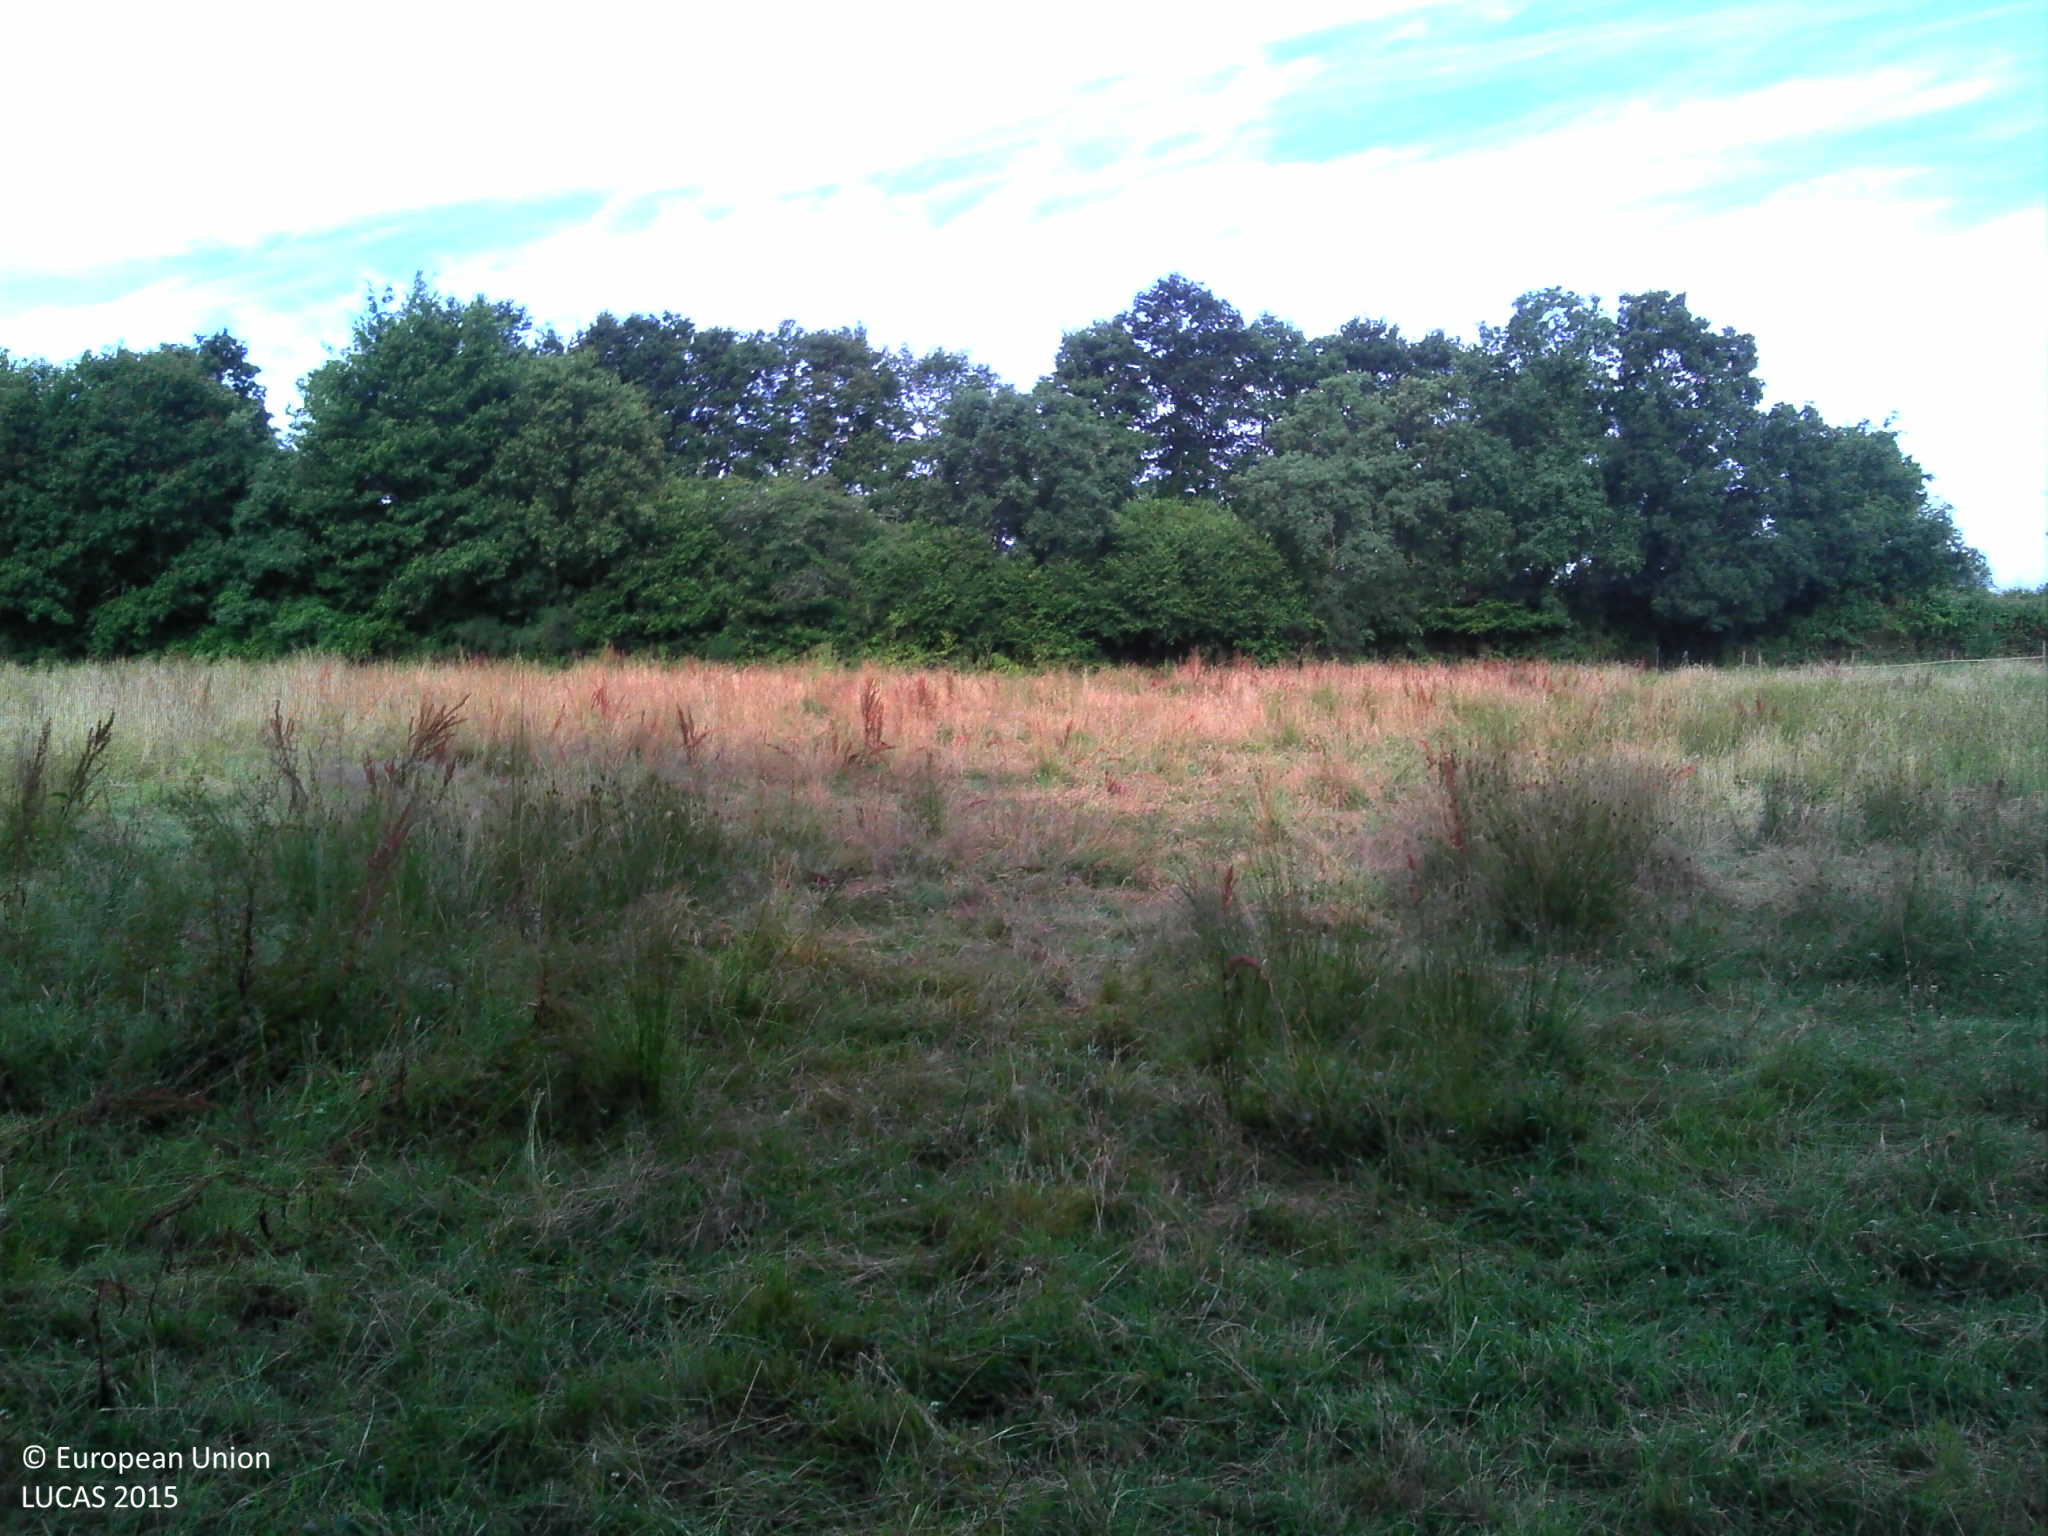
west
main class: Woodland
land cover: Broadleaved woodland
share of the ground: > 75 %
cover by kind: broadleaved forest trees 50 %, shrubs 40 %, herbaceous plants 10 %
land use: Agriculture (excluding fallow land and kitchen gardens)
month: June
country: FR
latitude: 47.3216
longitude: -1.5666
